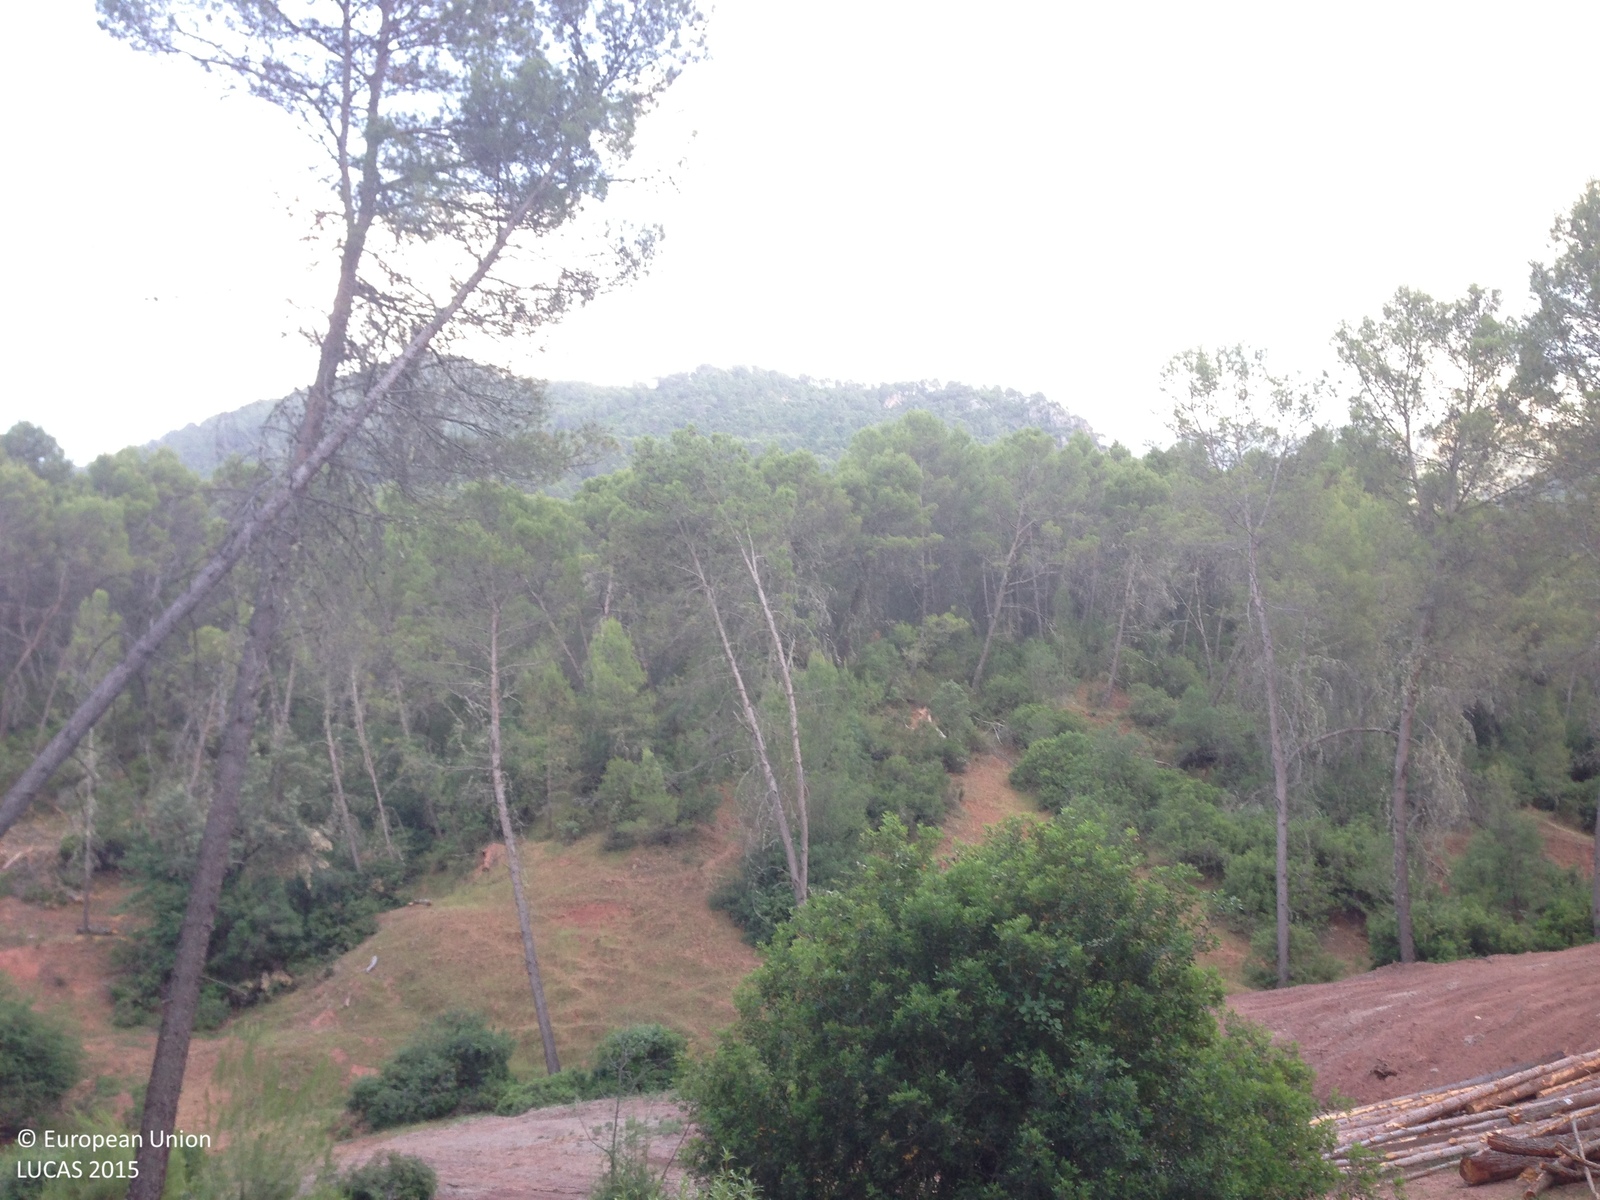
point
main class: Woodland
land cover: Pine dominated coniferous woodland
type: coniferous forest of the mediterranean region
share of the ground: > 75 %
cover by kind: coniferous forest trees 100 %
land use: Forestry
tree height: > 5 m
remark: Clear cut
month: June
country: ES
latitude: 38.0468
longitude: -2.8380
